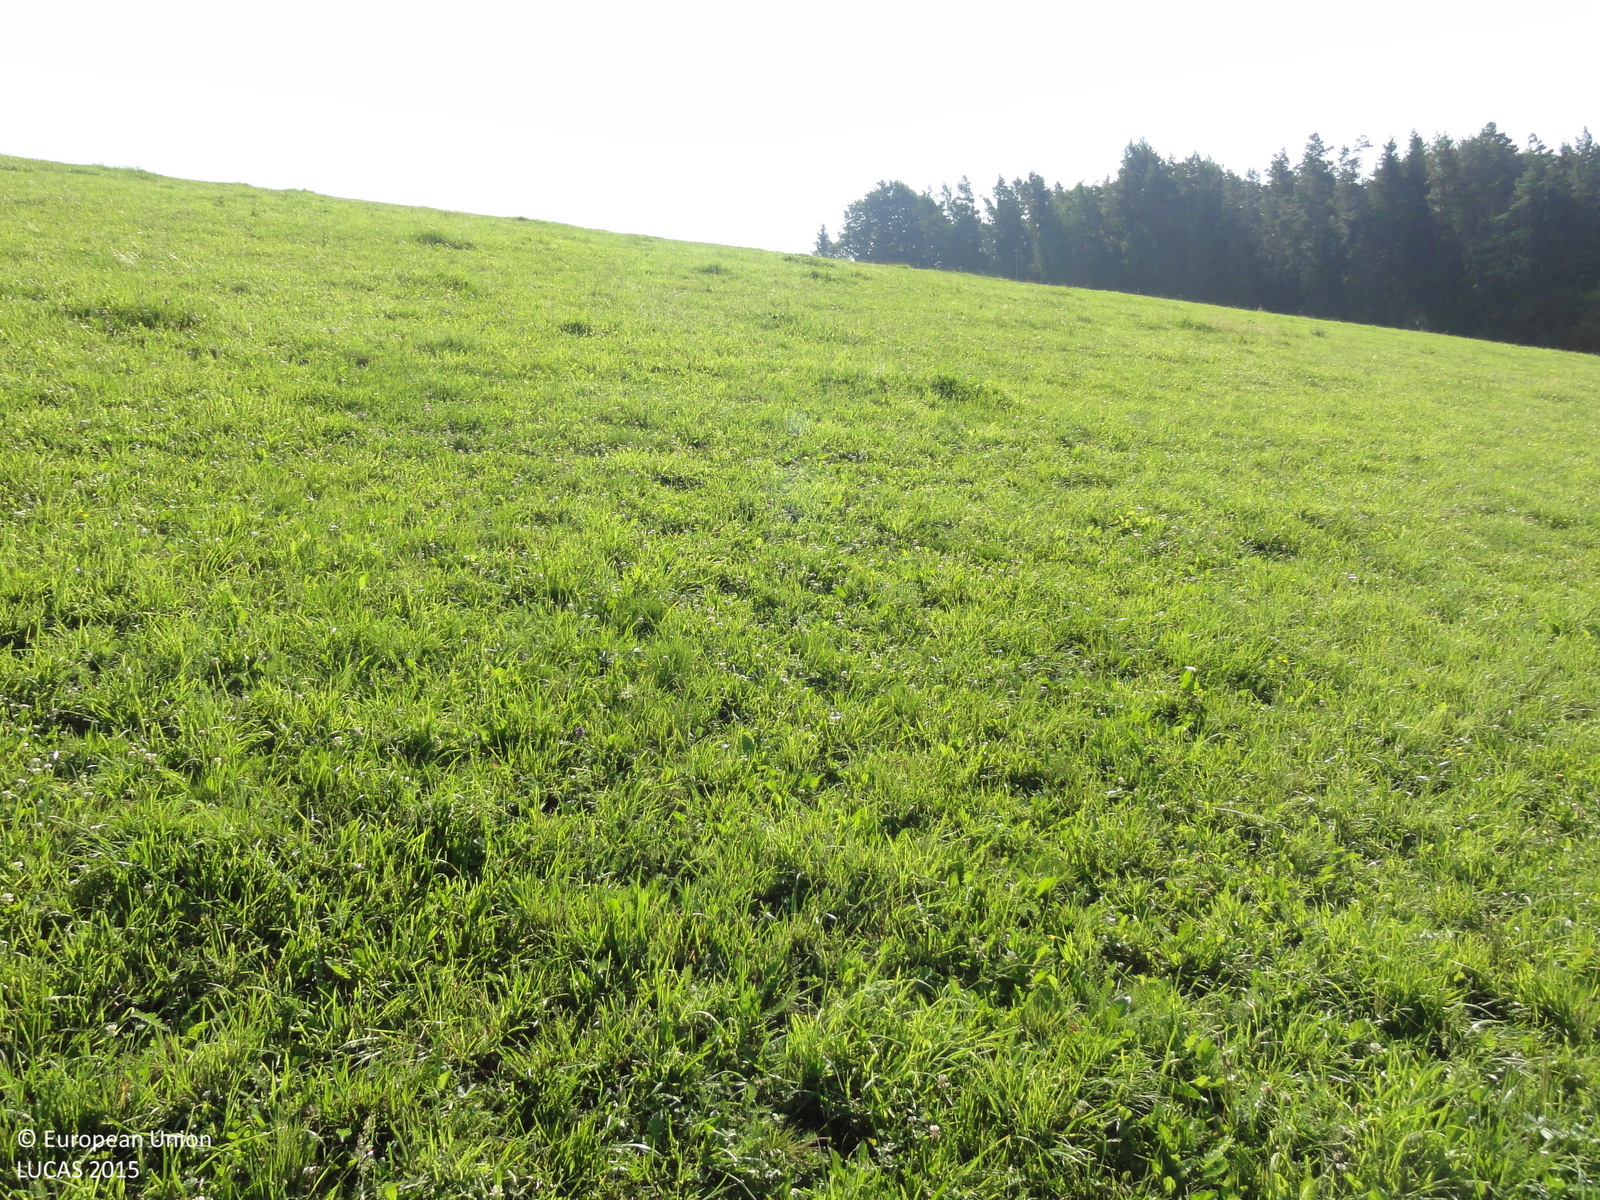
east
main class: Grassland
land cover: Grassland without tree/shrub cover
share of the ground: > 75 %
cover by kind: herbaceous plants 100 %
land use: Agriculture (excluding fallow land and kitchen gardens)
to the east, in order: Grassland without tree/shrub cover; Electric lines; Grassland without tree/shrub cover
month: July
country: SI
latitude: 46.4608
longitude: 15.5325
